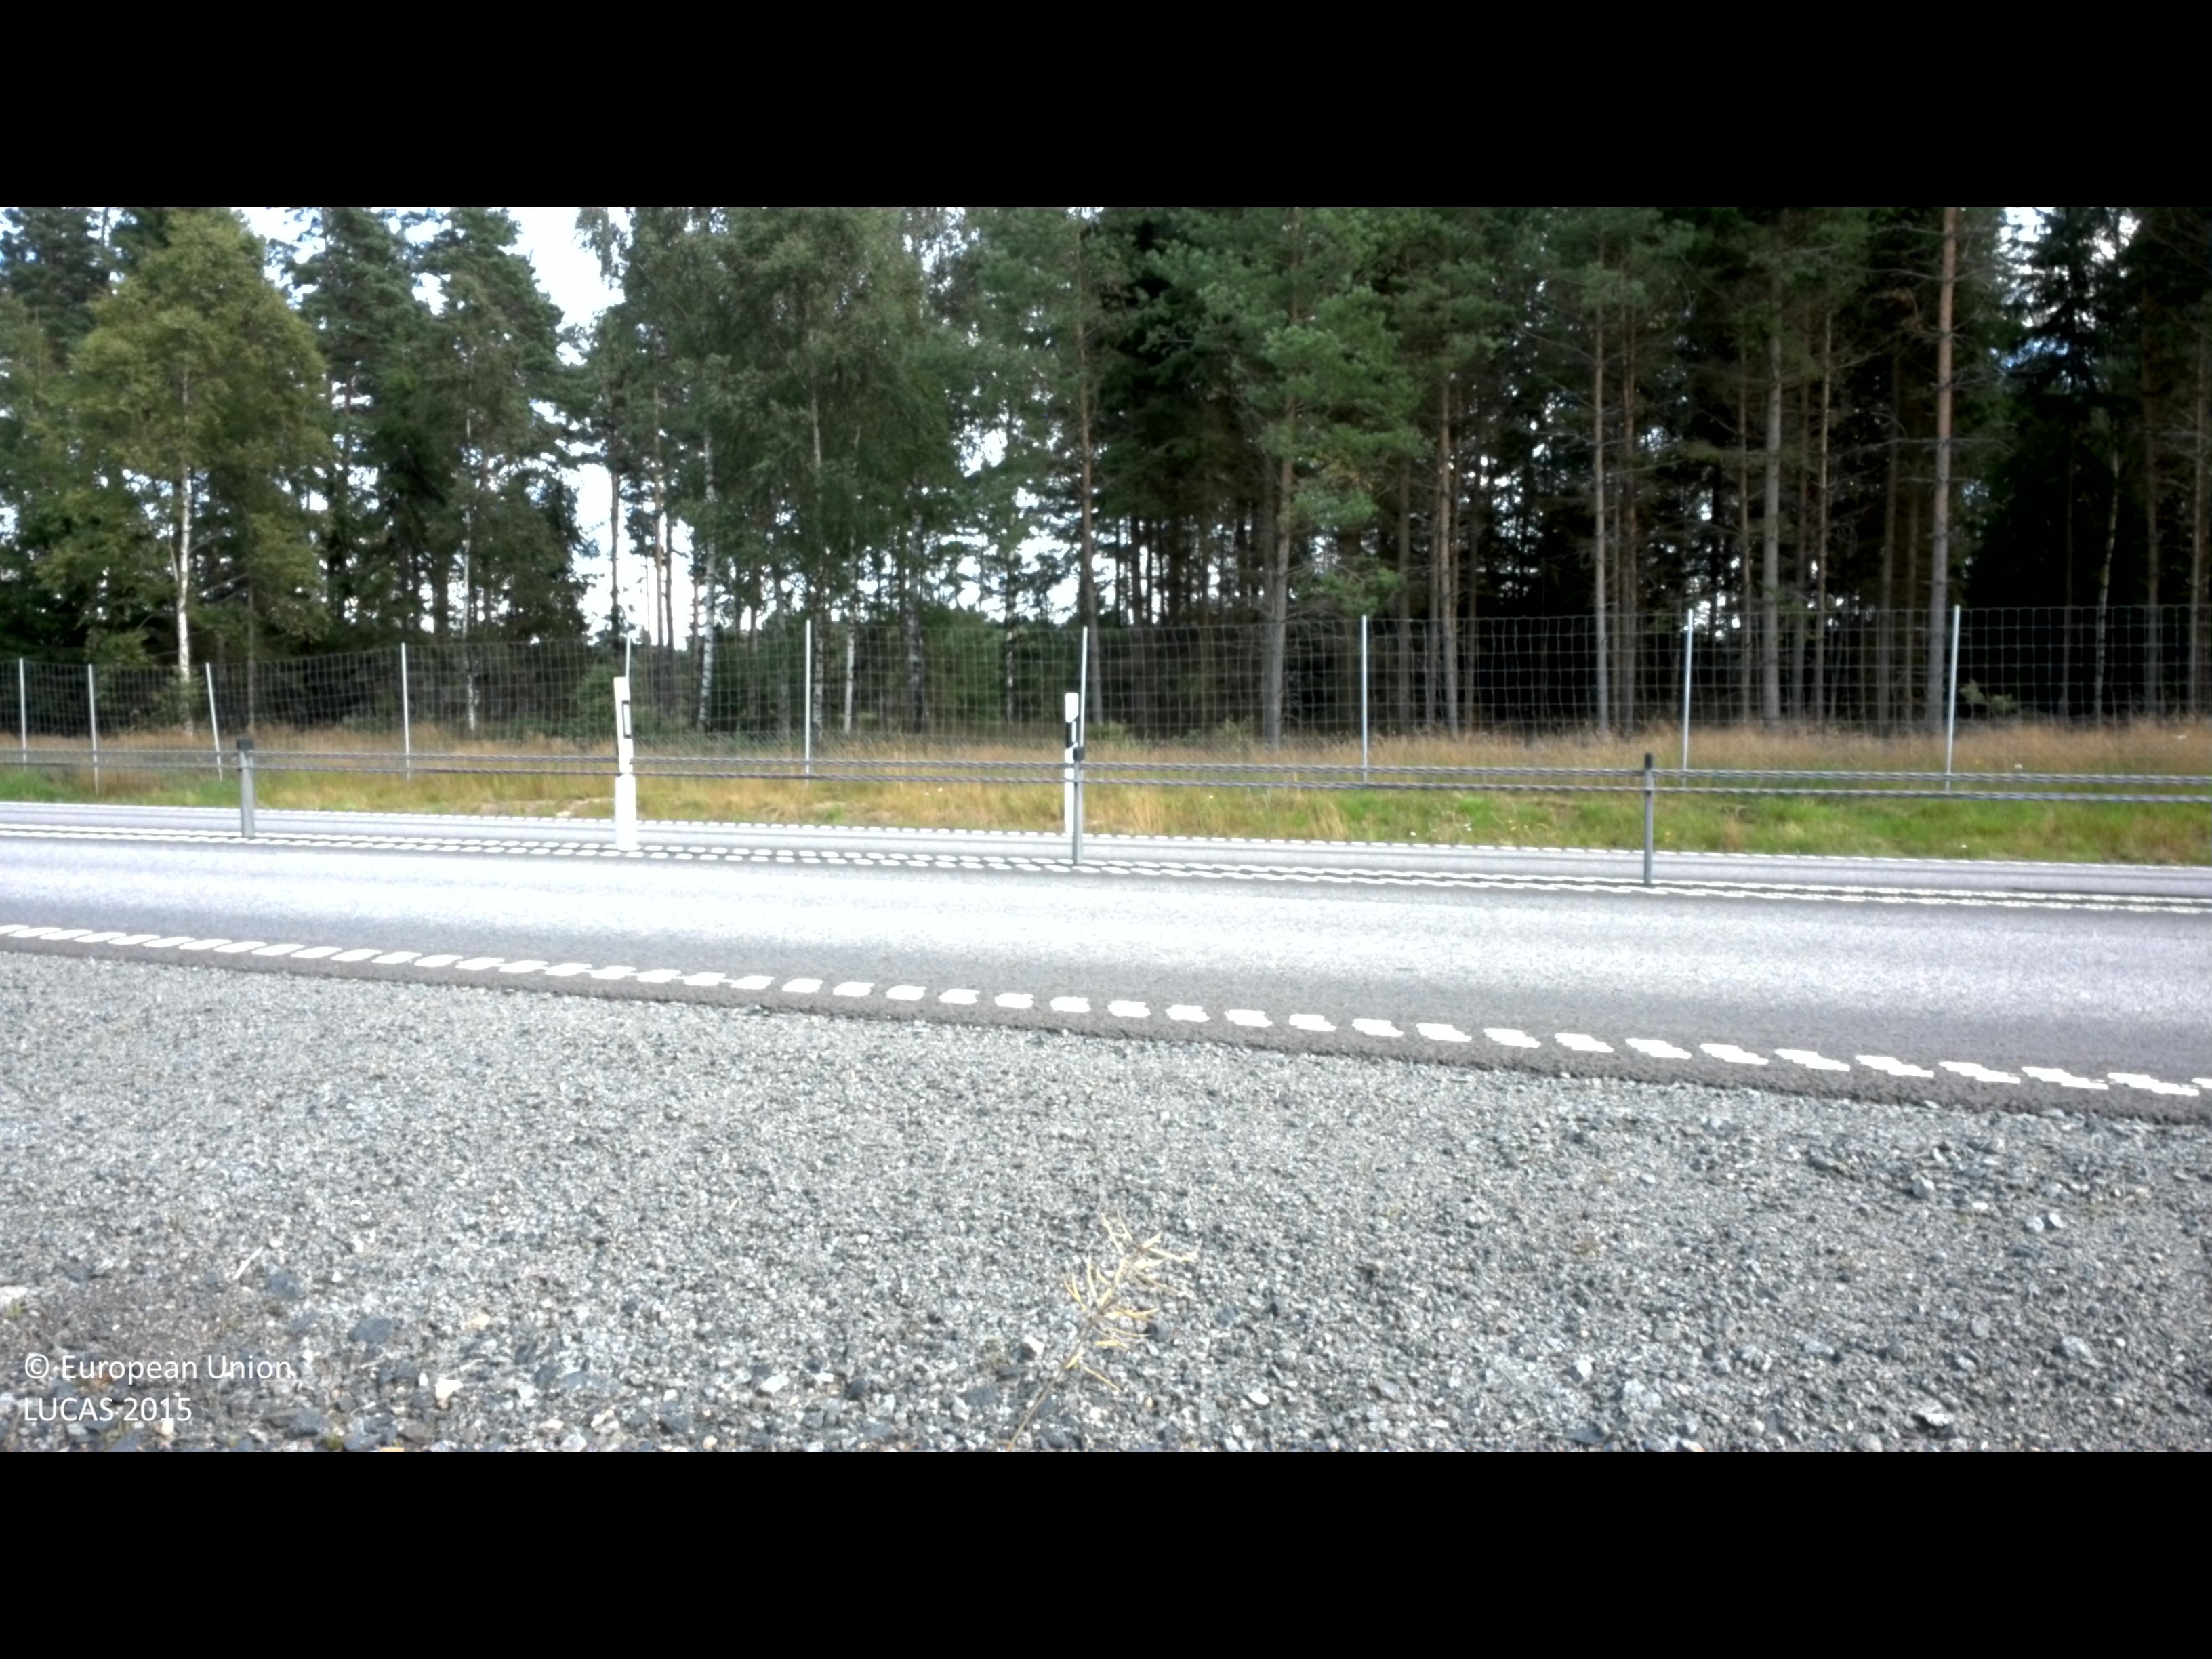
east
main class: Grassland
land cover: Grassland without tree/shrub cover
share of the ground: > 75 %
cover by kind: herbaceous plants 90 %, consolidated bare surface 10 %
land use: Road transport
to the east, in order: Ditches and canals; Paved roads, cycling and walking lanes; Ditches and canals; Grassland without tree/shrub cover; Fences; Spruce dominated mixed woodland; Pine dominated coniferous woodland; Broadleaved woodland; Electric lines; Pine dominated coniferous woodland; Shrubland with sparse tree cover; Pine dominated coniferous woodland
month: August
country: SE
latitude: 56.6564
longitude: 14.2873
